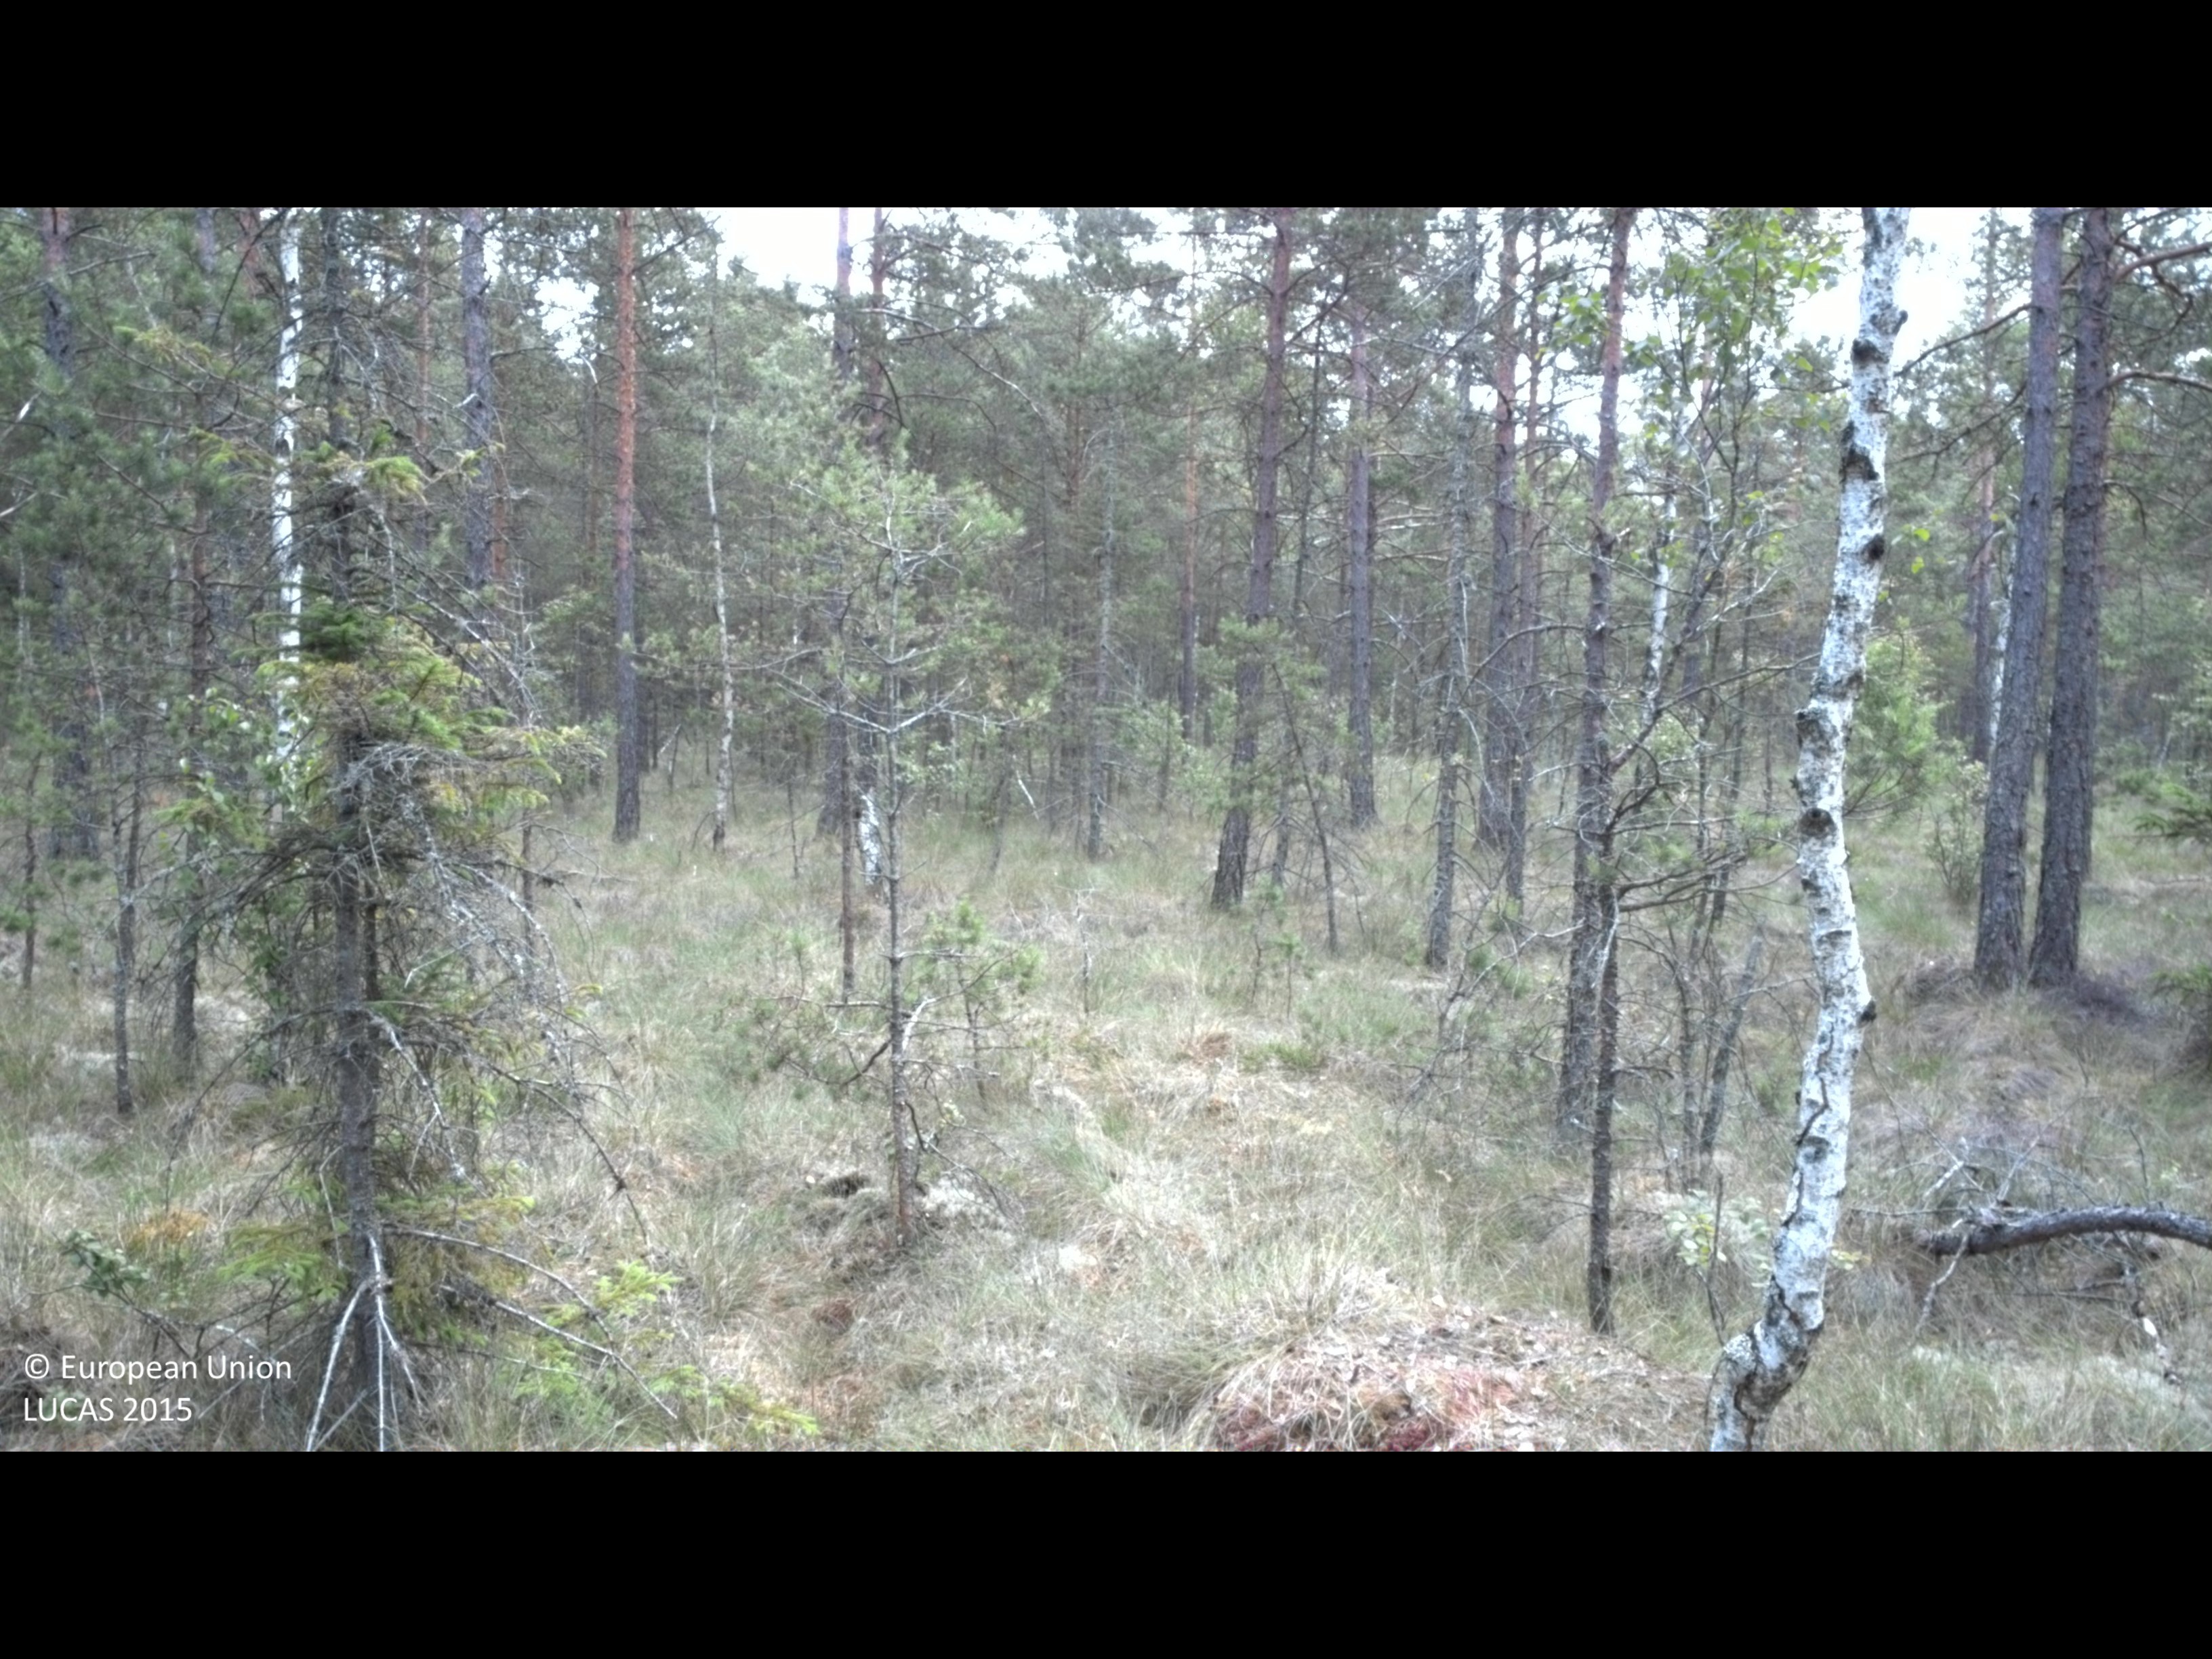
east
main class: Woodland
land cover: Pine dominated mixed woodland
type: mire and swamp forests
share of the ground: 50 - 75 %
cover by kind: coniferous forest trees 40 %, broadleaved forest trees 20 %, herbaceous plants 20 %, shrubs 10 %, lichens and mosses 10 %
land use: Semi-natural and natural areas not in use
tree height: > 5 m
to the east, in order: Pine dominated mixed woodland; Ditches and canals; Spruce dominated coniferous woodland; Fences; Grassland with sparse tree/shrub cover; Grassland without tree/shrub cover; Fences; Grass margins; Paved roads, cycling and walking lanes; Grass margins; Fences; Sand; Fences; Grassland without tree/shrub cover; Electric lines; Fences; Dry stone walls; Broadleaved woodland
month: July
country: SE
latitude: 56.5667
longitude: 14.2772
